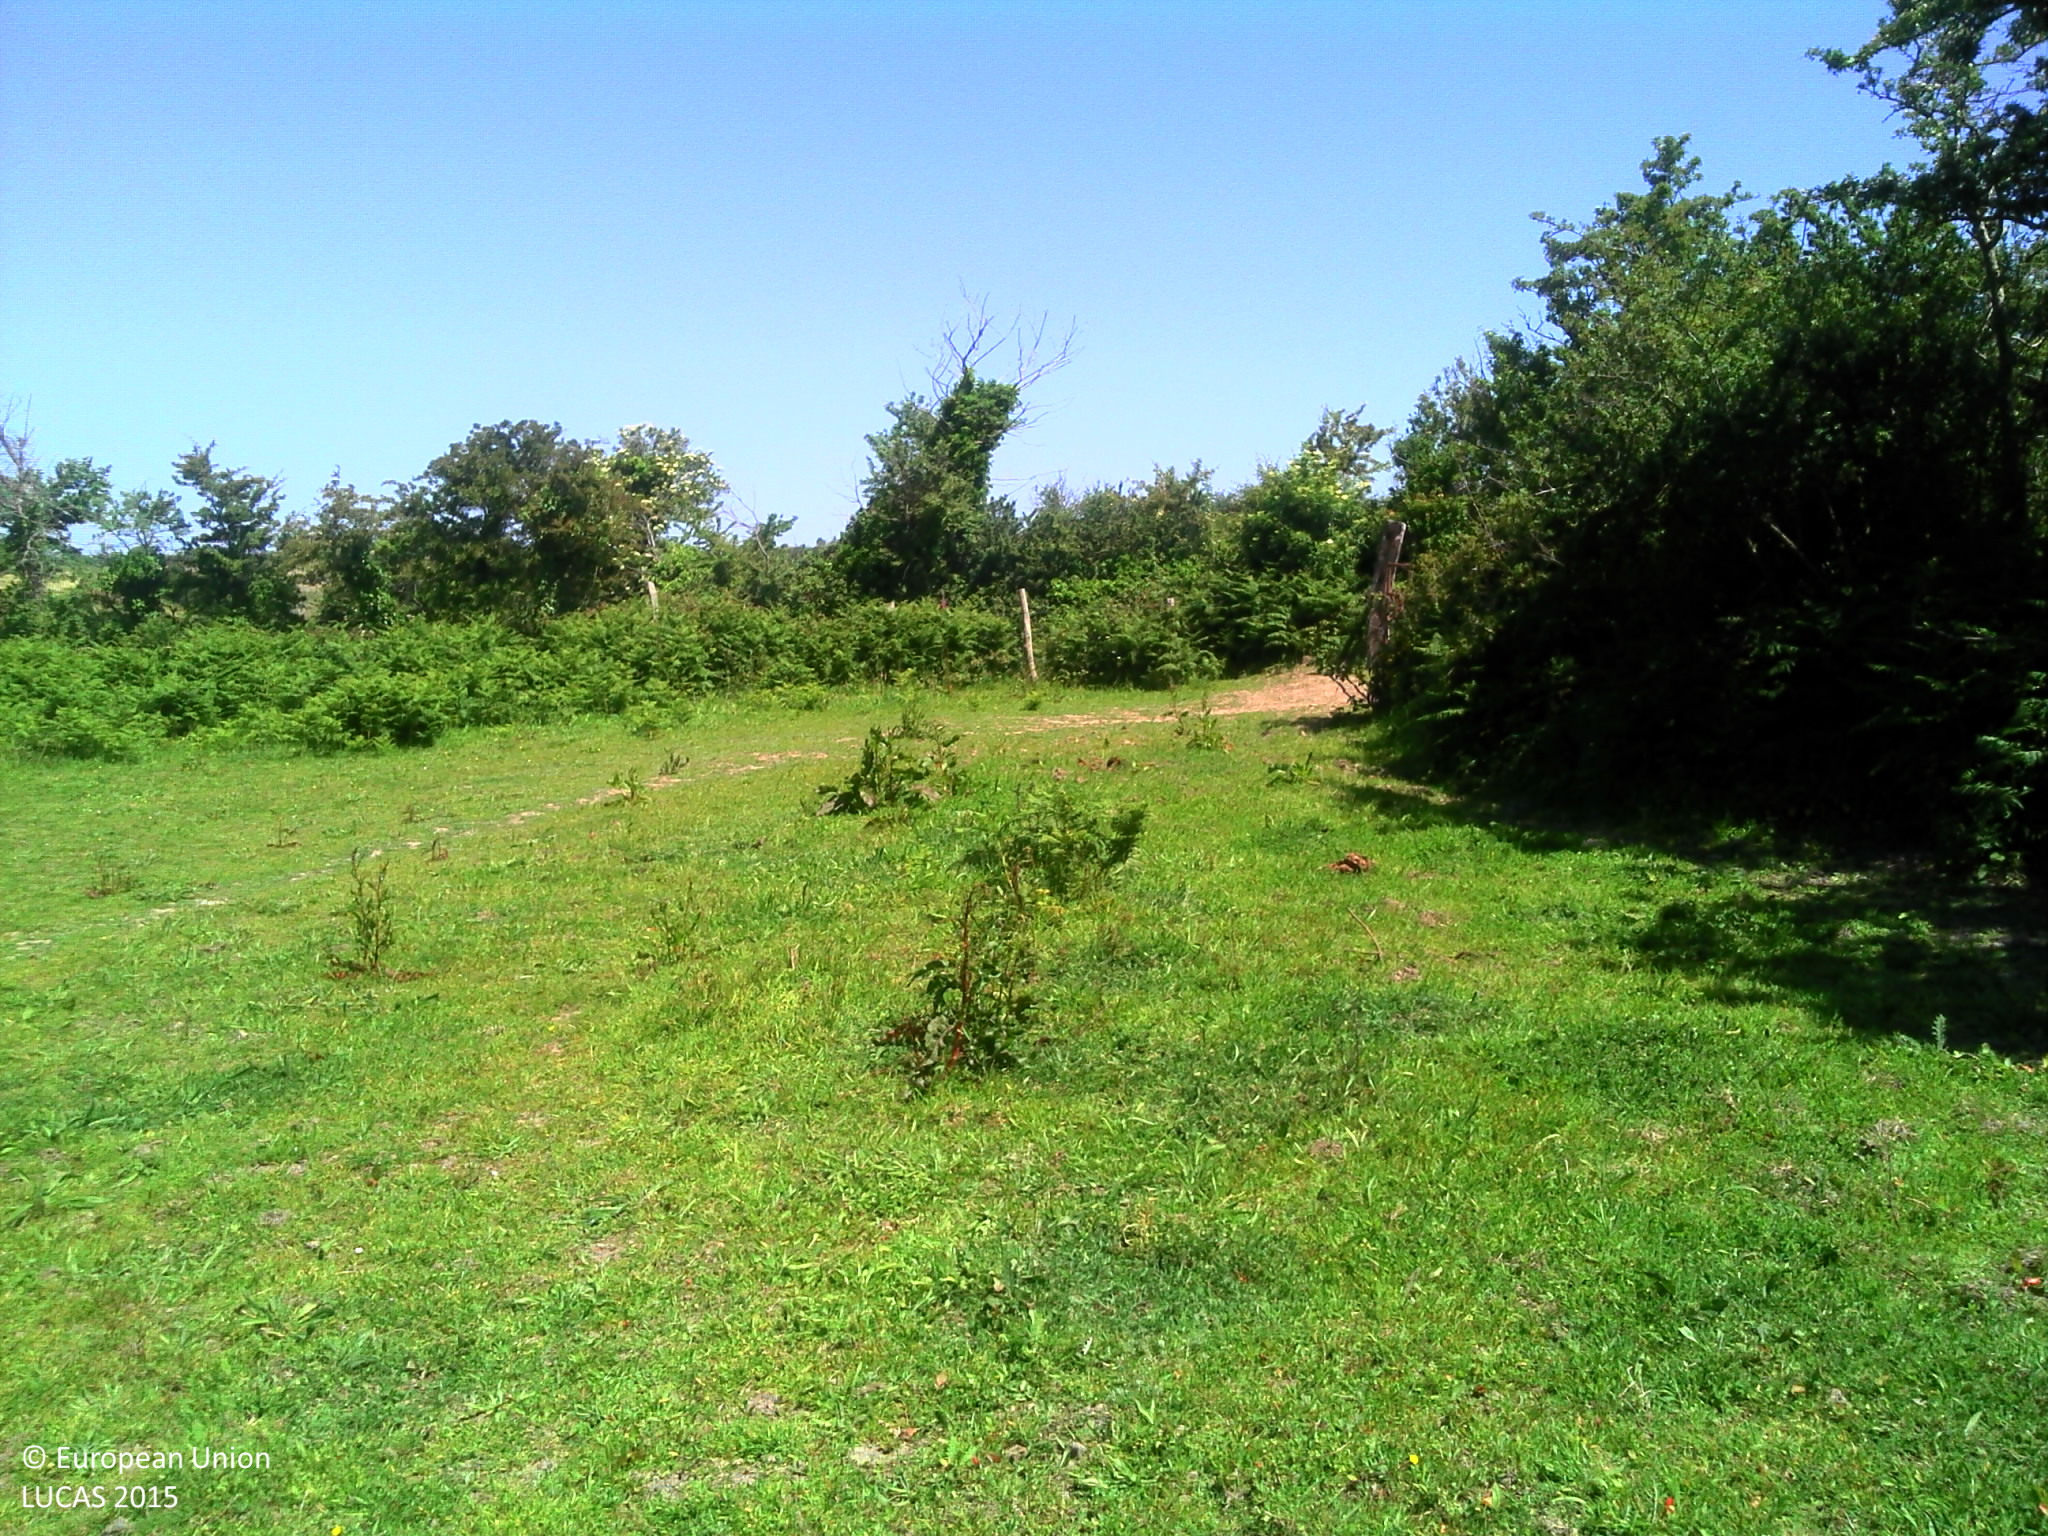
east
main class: Grassland
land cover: Grassland without tree/shrub cover
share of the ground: > 75 %
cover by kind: herbaceous plants 100 %
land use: Agriculture (excluding fallow land and kitchen gardens)
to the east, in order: Grassland without tree/shrub cover; Abandoned hedges; Grass margins; Tracks; Grass margins; Abandoned hedges; Grassland without tree/shrub cover; Abandoned hedges; Grassland without tree/shrub cover; Abandoned hedges; Grassland without tree/shrub cover; Abandoned hedges; Grassland without tree/shrub cover; Lines of trees; Grassland without tree/shrub cover; Lines of trees; Grassland without tree/shrub cover; Lines of trees; Grassland without tree/shrub cover
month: June
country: FR
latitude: 49.6541
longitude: -1.5051
